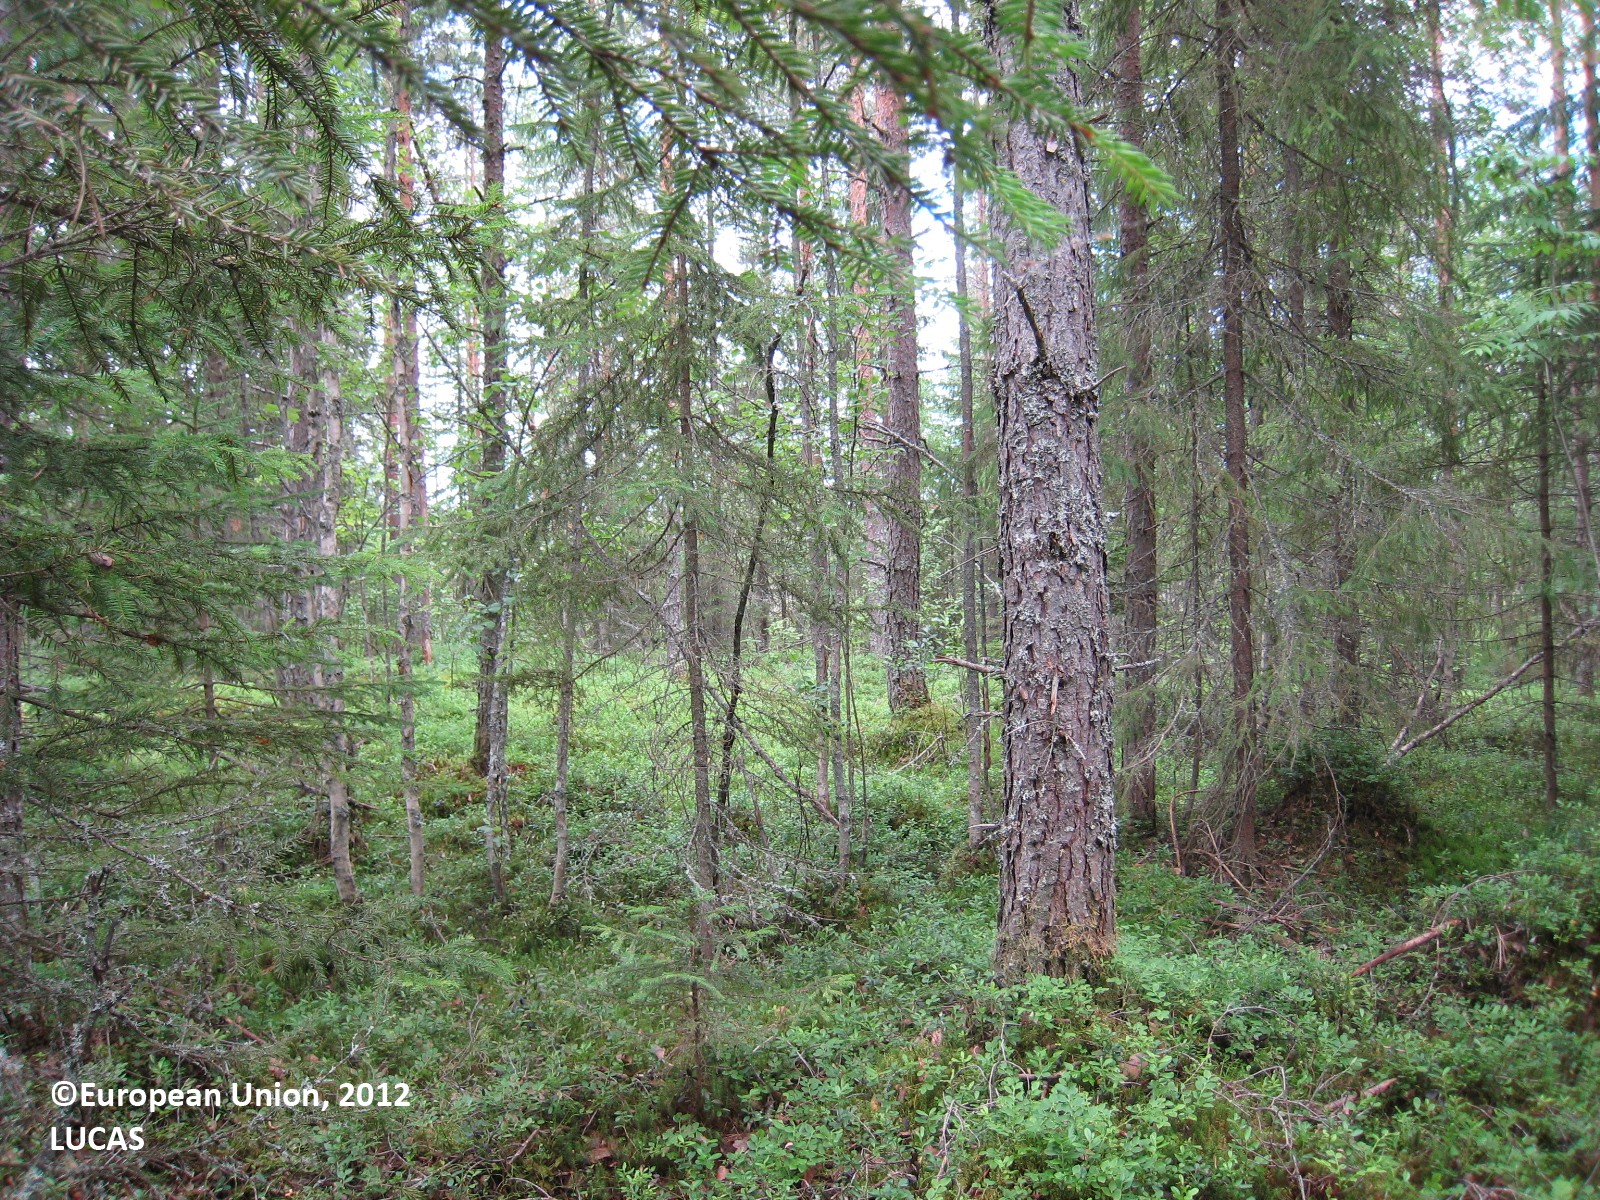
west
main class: Woodland
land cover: Other mixed woodland
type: boreal forest
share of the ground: > 75 %
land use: Forestry
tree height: > 5 m
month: July
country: FI
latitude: 63.2027
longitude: 26.9015
